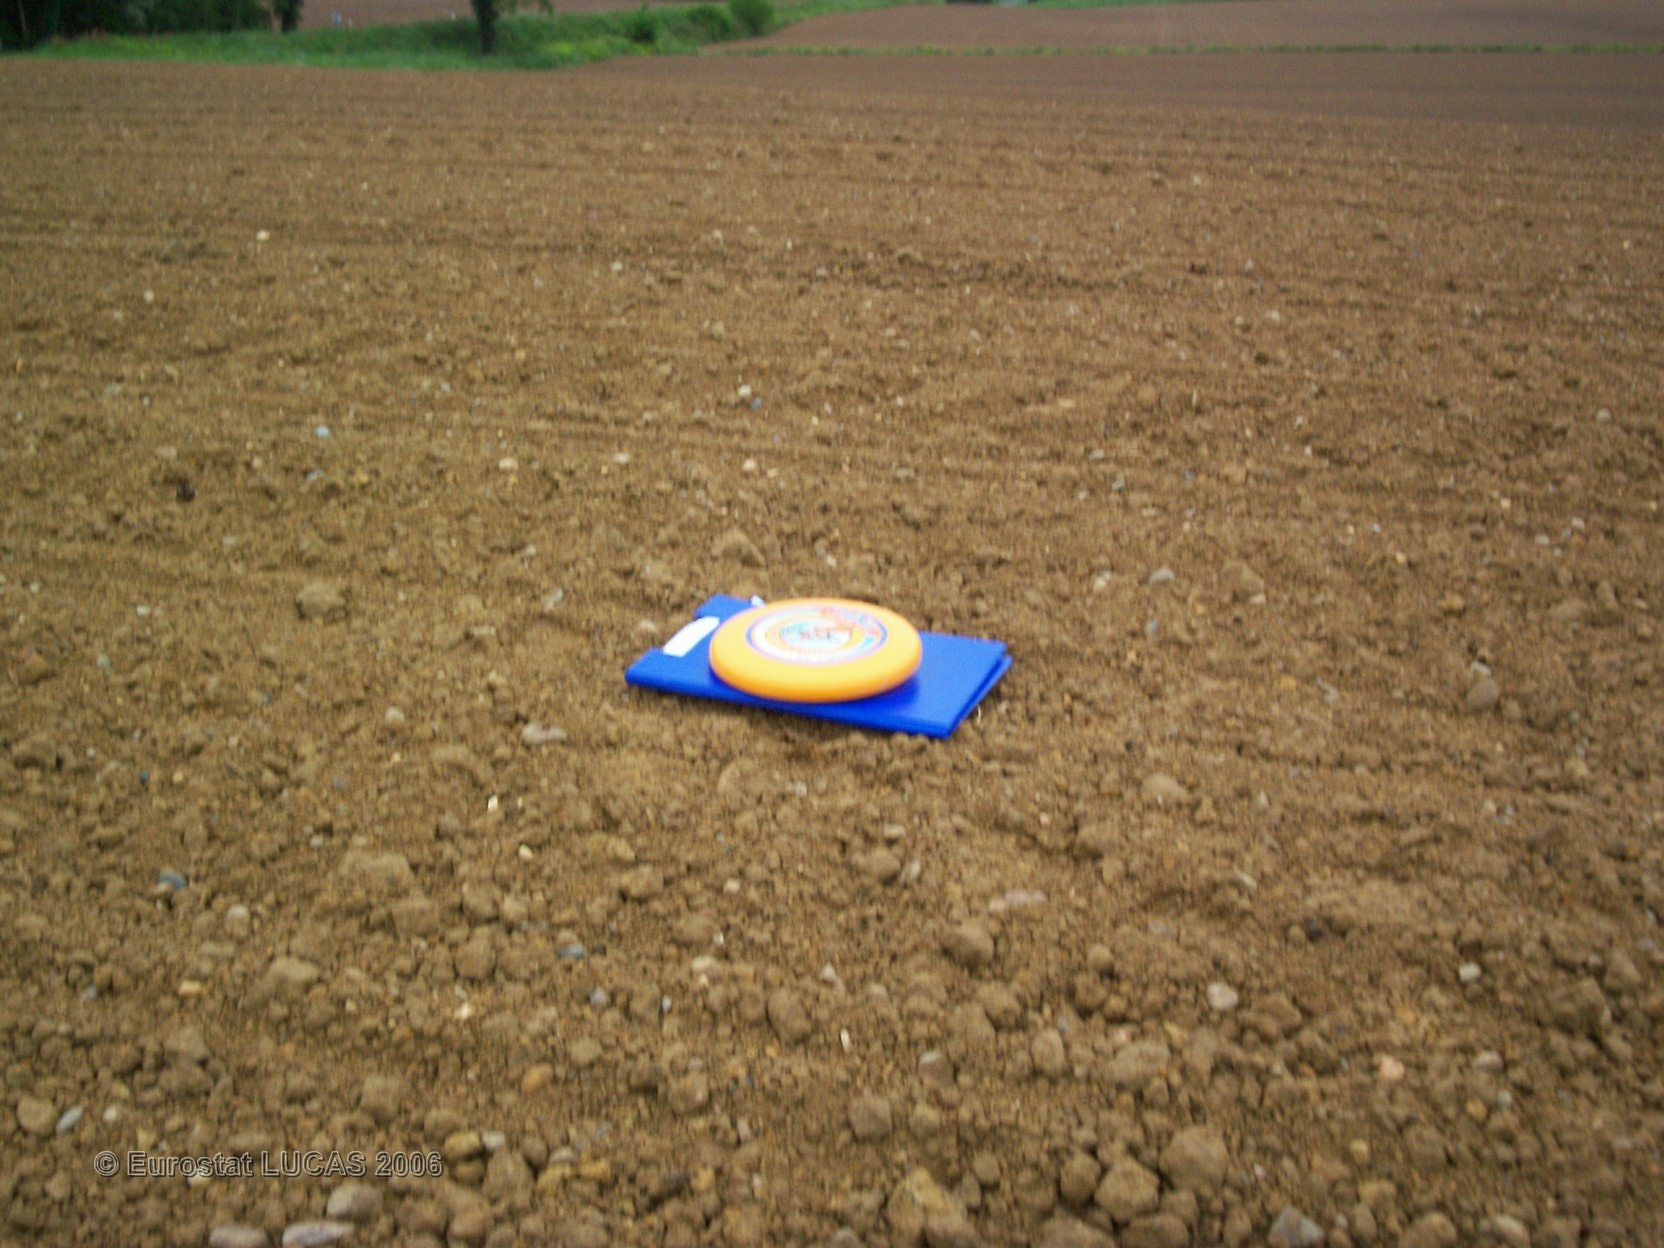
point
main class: Cropland
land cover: Maize
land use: Agriculture (excluding fallow land and kitchen gardens)
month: April
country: FR
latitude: 43.6488
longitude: -0.3614
